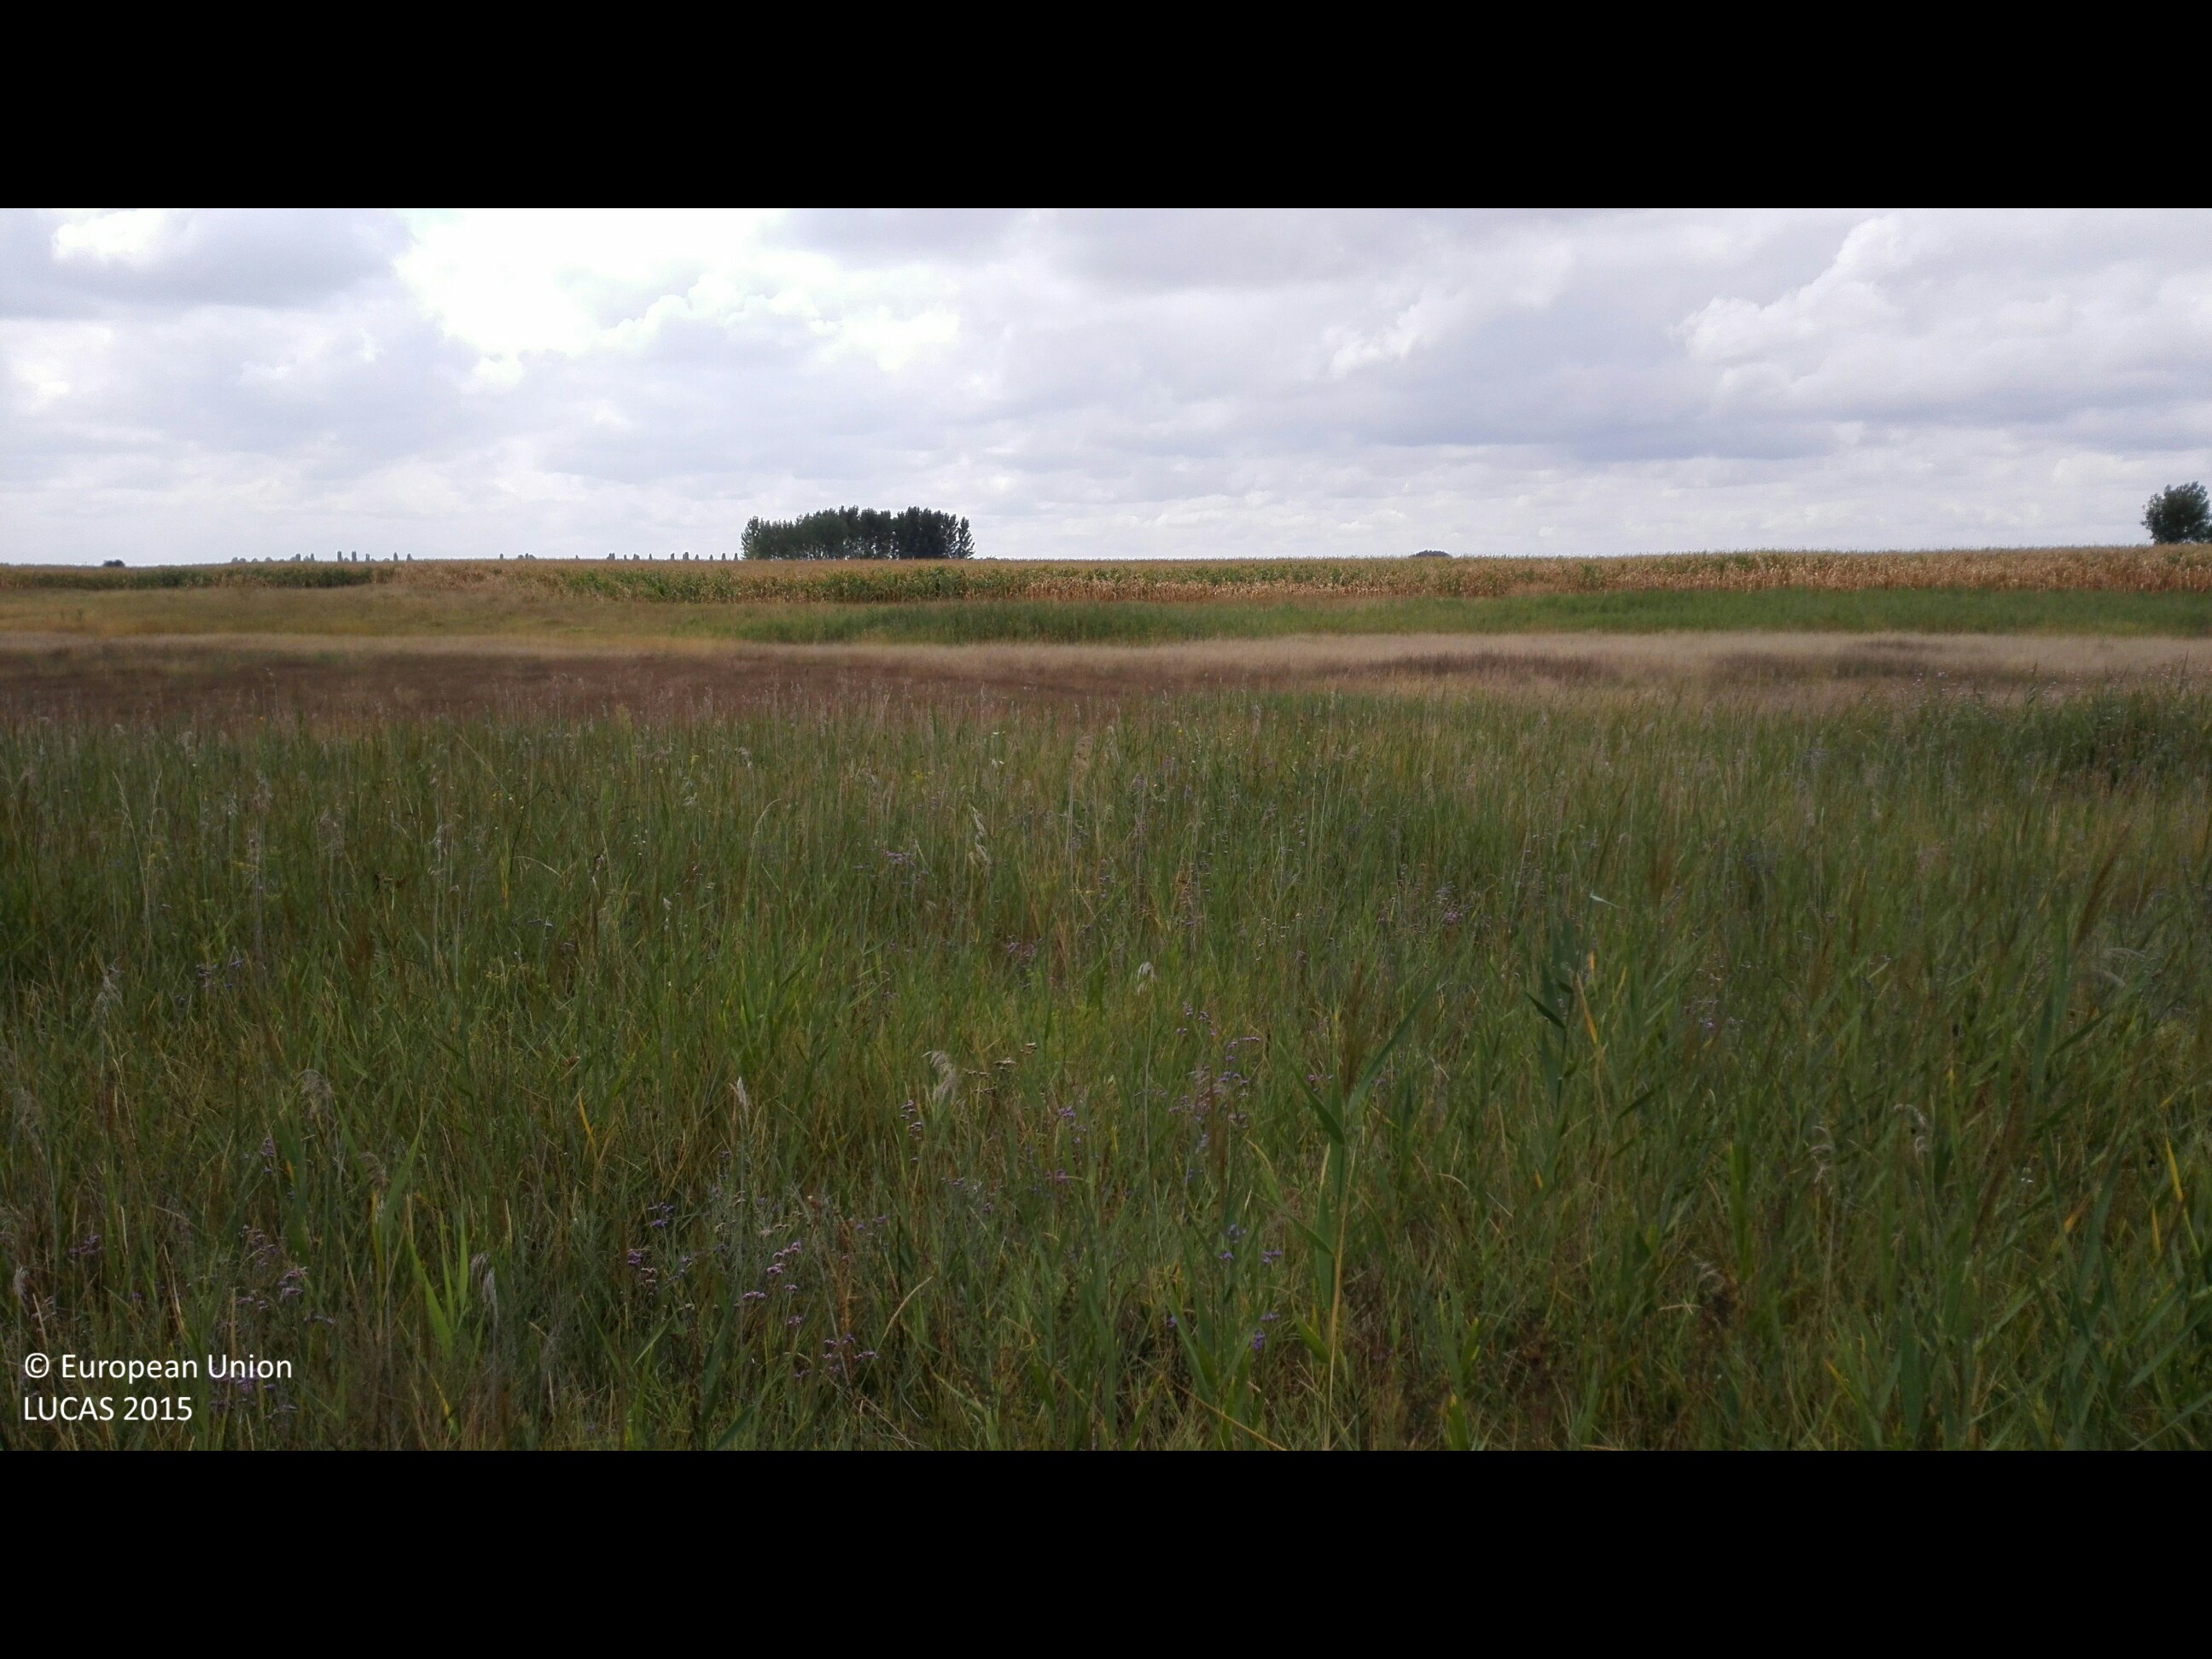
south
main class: Grassland
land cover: Grassland without tree/shrub cover
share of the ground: > 75 %
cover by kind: herbaceous plants 100 %
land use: Semi-natural and natural areas not in use
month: August
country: HU
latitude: 47.3401
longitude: 21.7318
